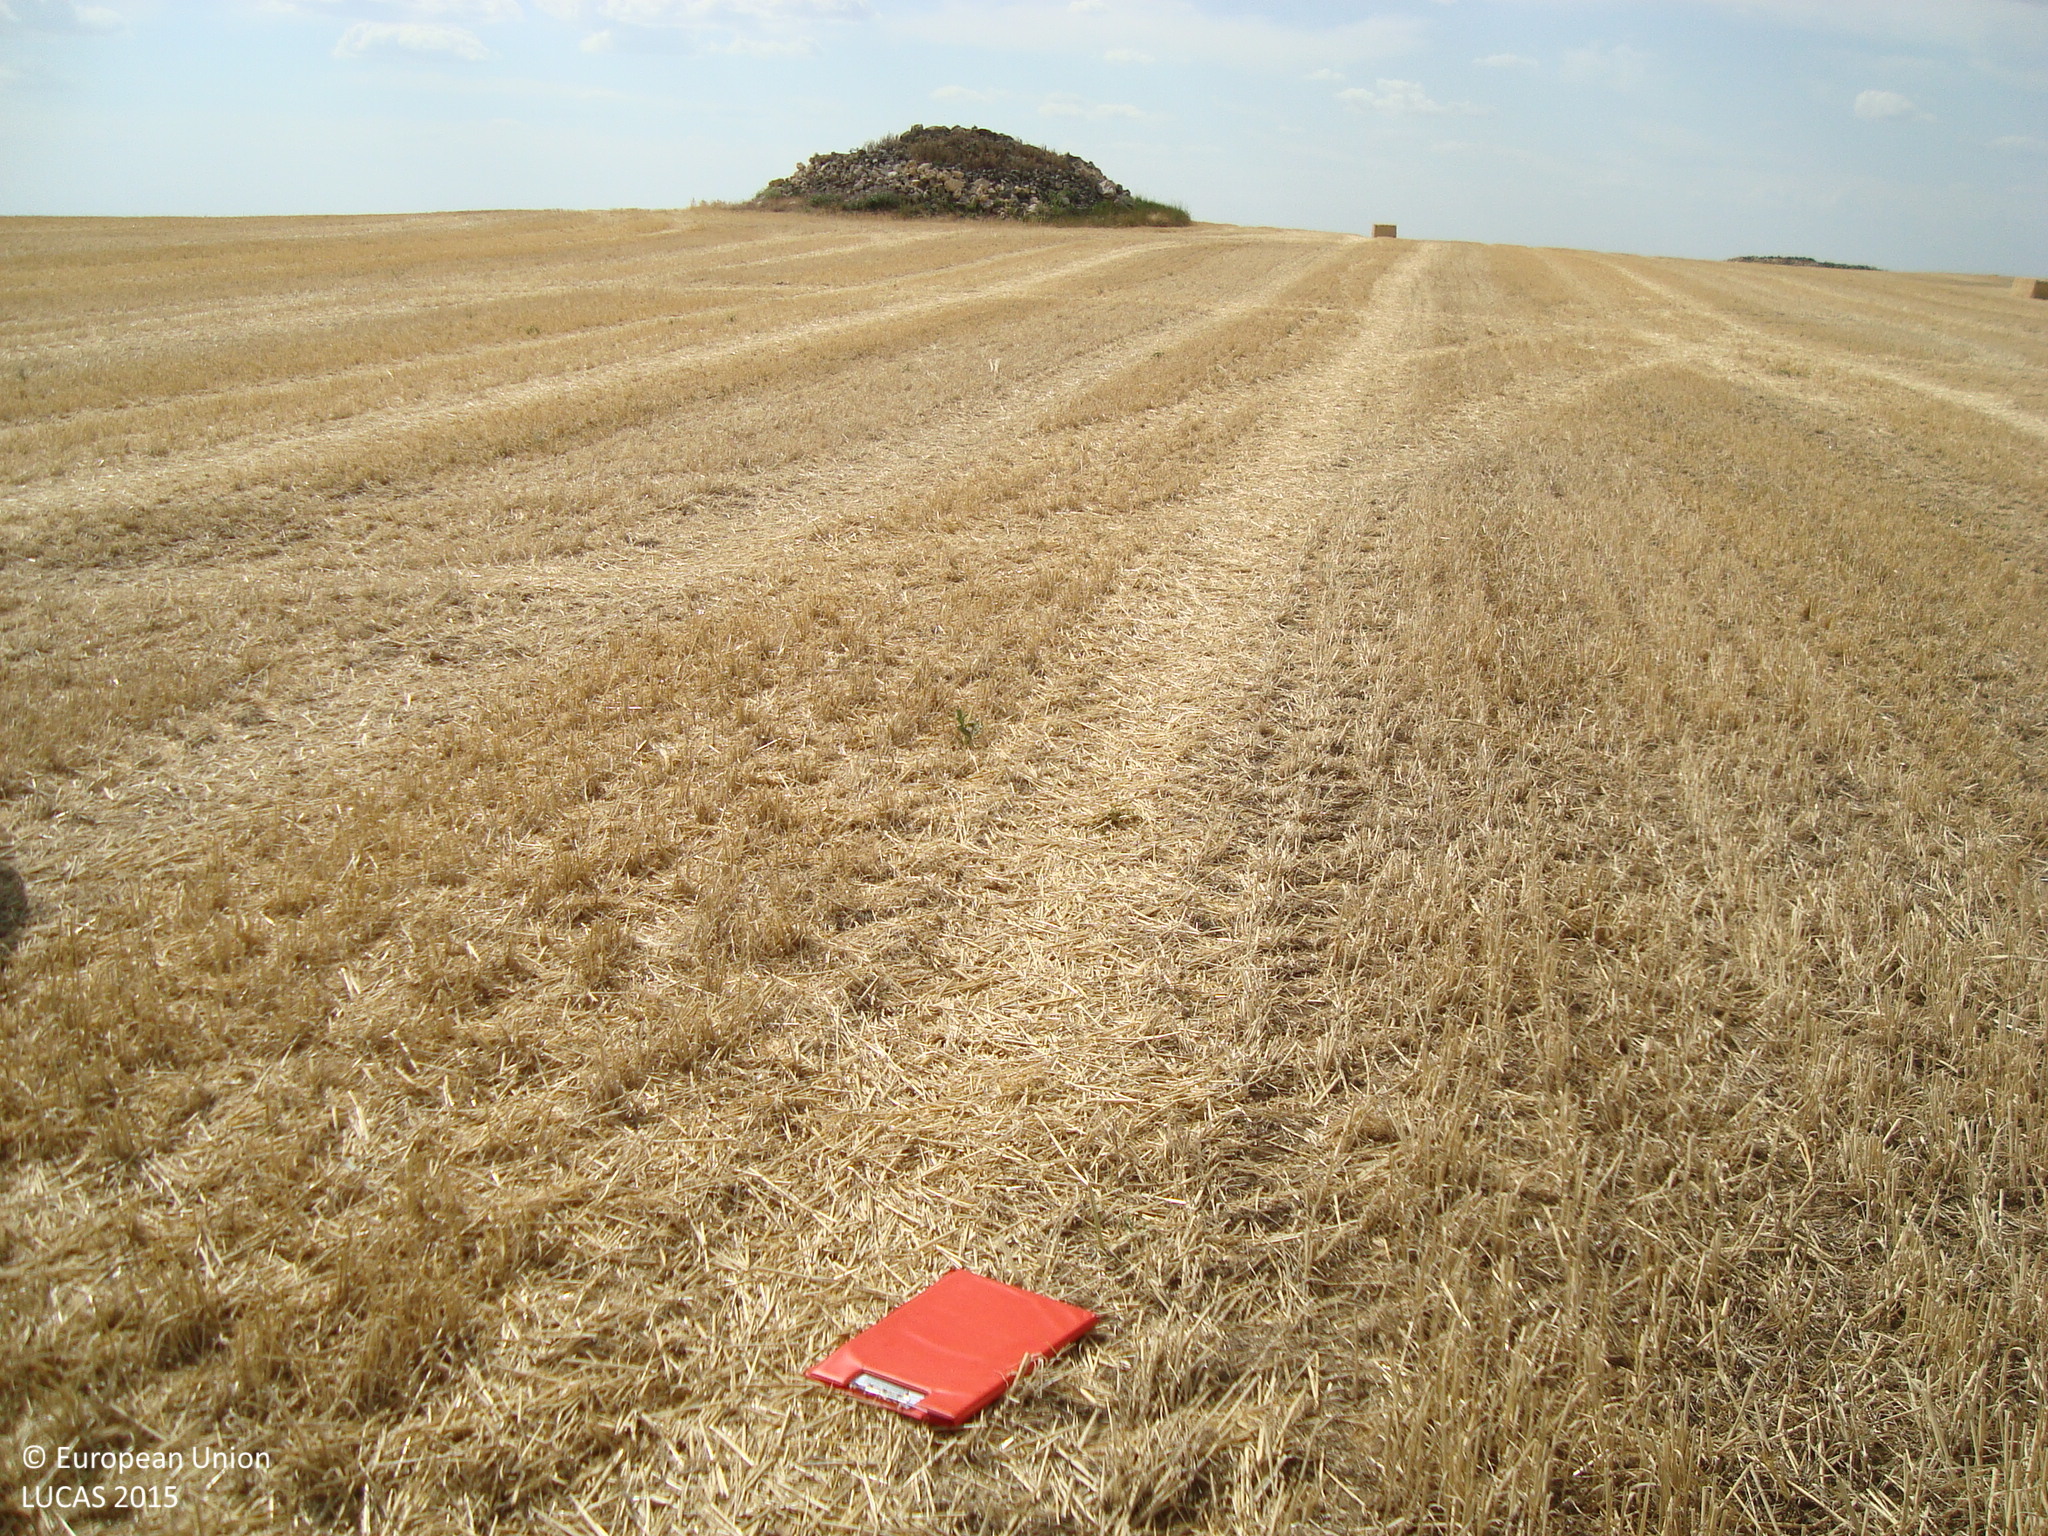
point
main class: Cropland
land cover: Barley
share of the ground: > 75 %
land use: Agriculture (excluding fallow land and kitchen gardens)
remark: Harvested field
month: July
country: ES
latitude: 41.9914
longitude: -4.1016
